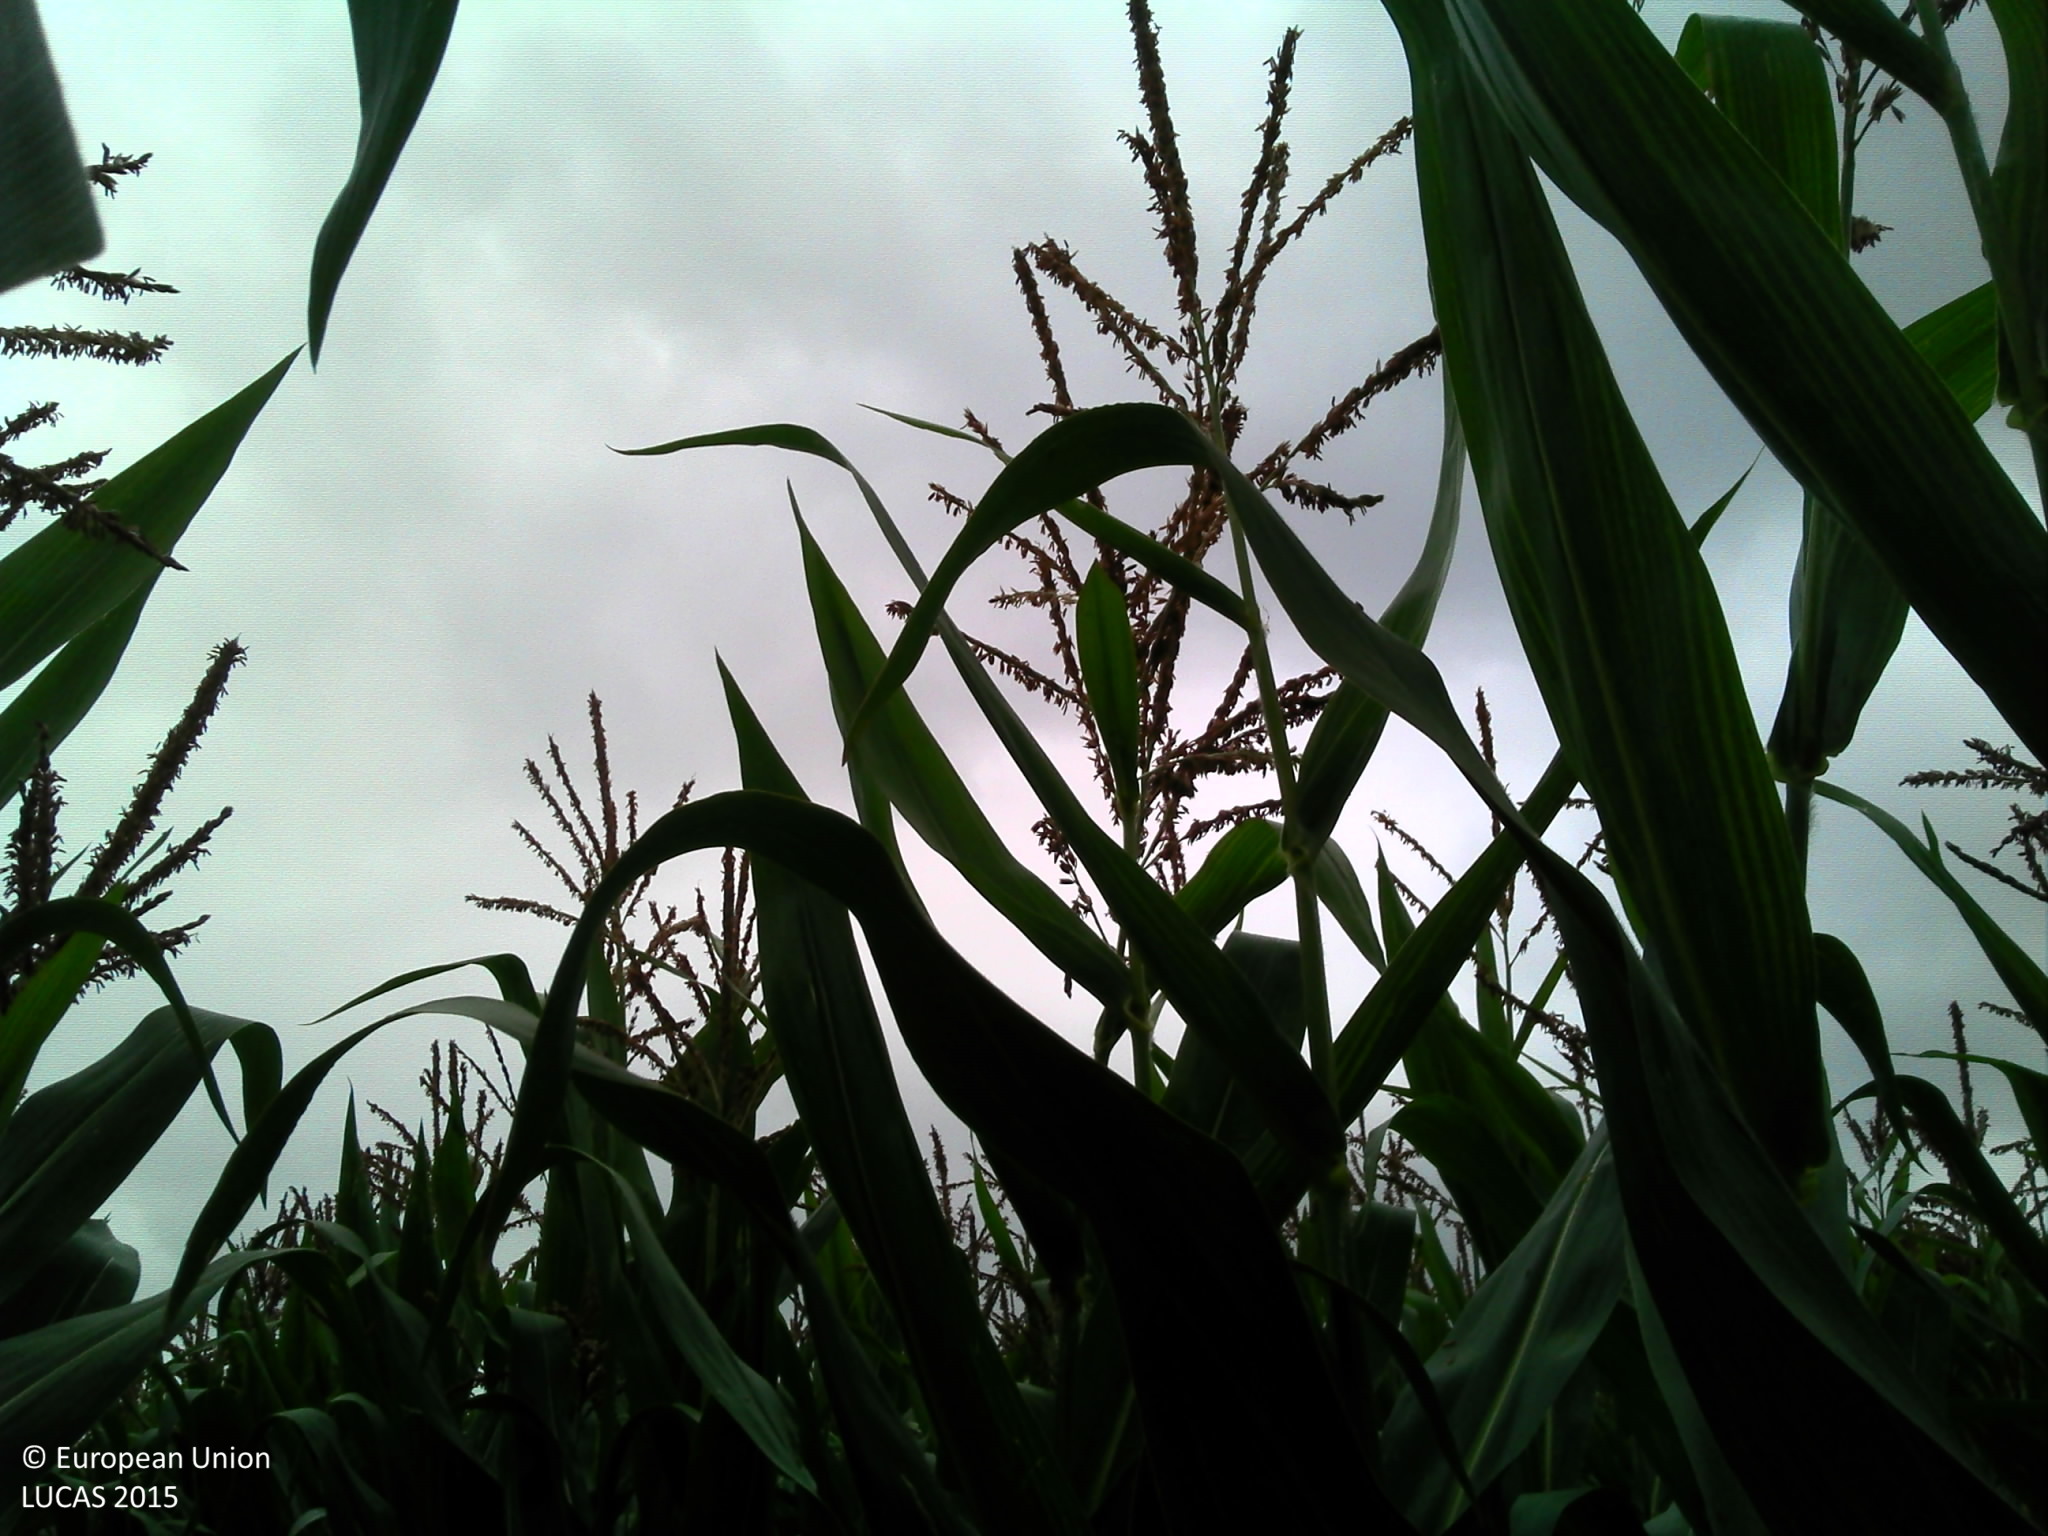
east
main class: Cropland
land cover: Maize
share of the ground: > 75 %
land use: Agriculture (excluding fallow land and kitchen gardens)
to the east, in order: Maize; Abandoned hedges; Maize; Abandoned hedges; Other fresh vegetables; Common wheat; Artificial constructions in urban areas; Grassland without tree/shrub cover; Abandoned hedges; Other fresh vegetables; Abandoned hedges; Other fresh vegetables
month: August
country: FR
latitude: 48.8204
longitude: -3.2736
